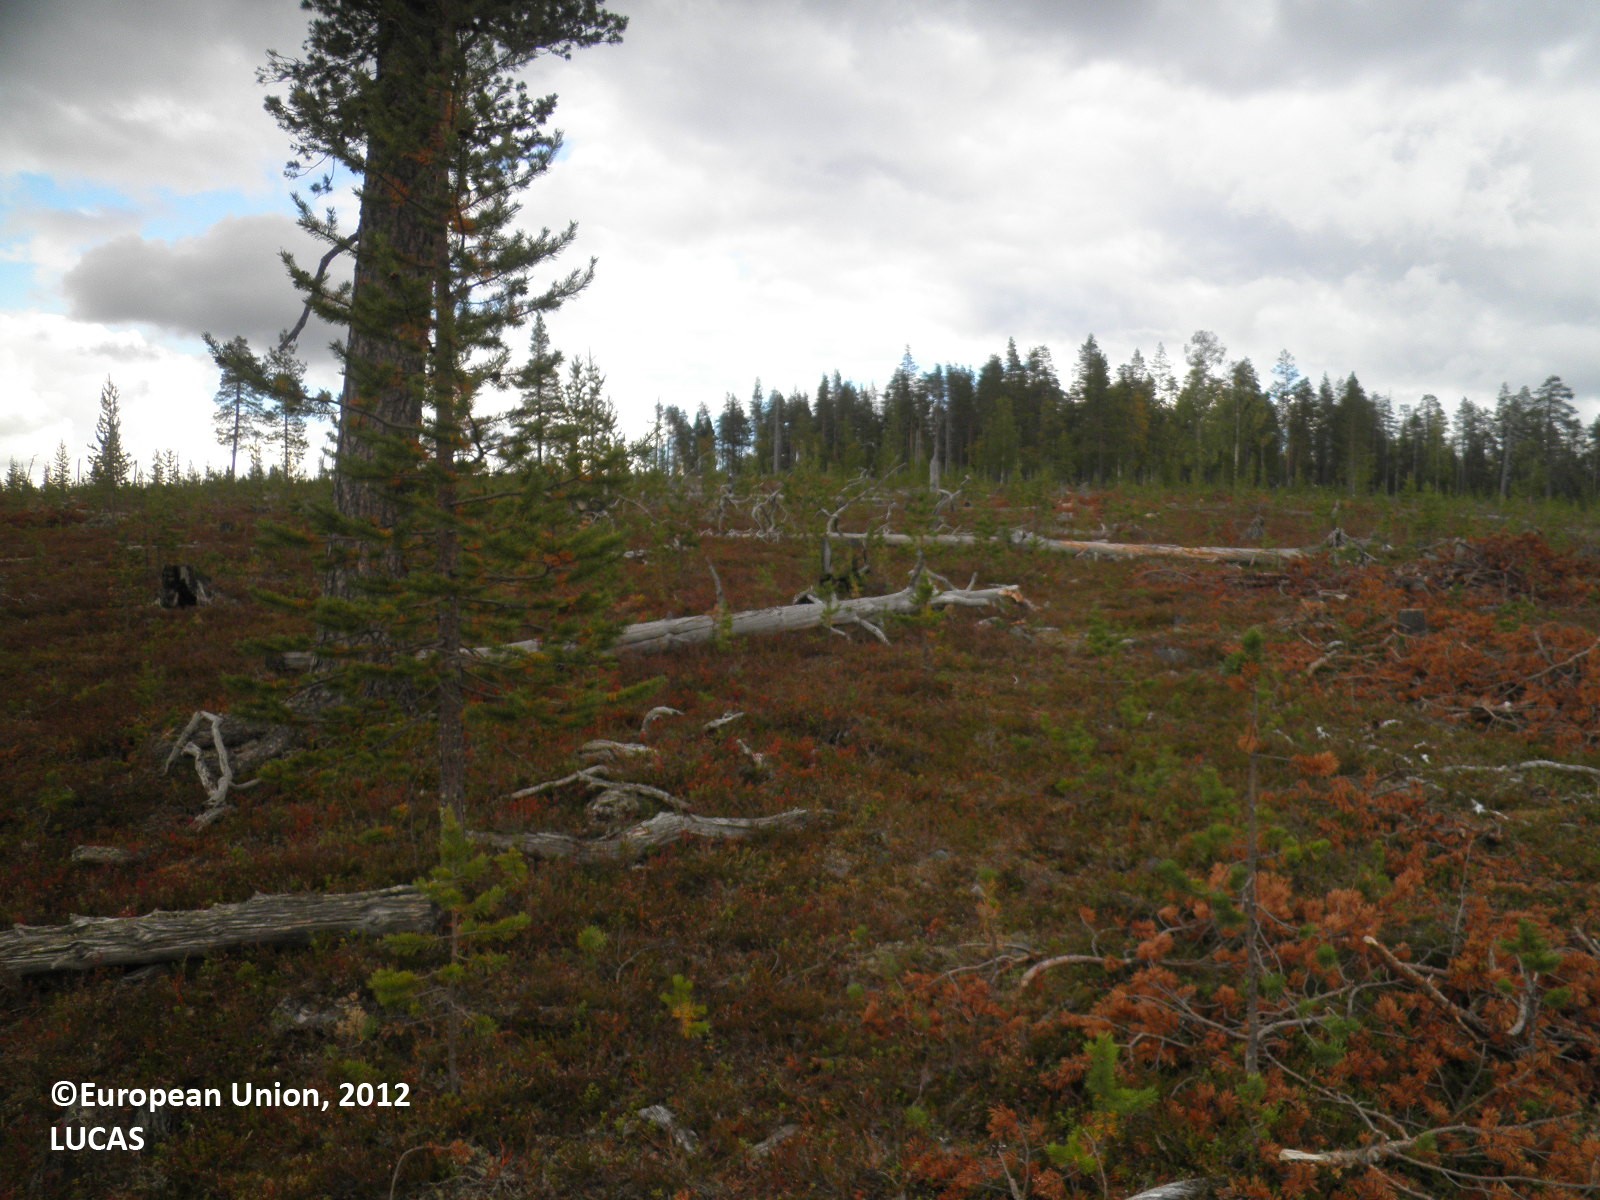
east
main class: Woodland
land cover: Pine dominated coniferous woodland
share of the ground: 10 - 25 %
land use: Forestry
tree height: < 5 m
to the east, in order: Pine dominated coniferous woodland; Shrubland with sparse tree cover; Pine dominated coniferous woodland; Pine dominated mixed woodland
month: August
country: FI
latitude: 67.9261
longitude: 28.2588
